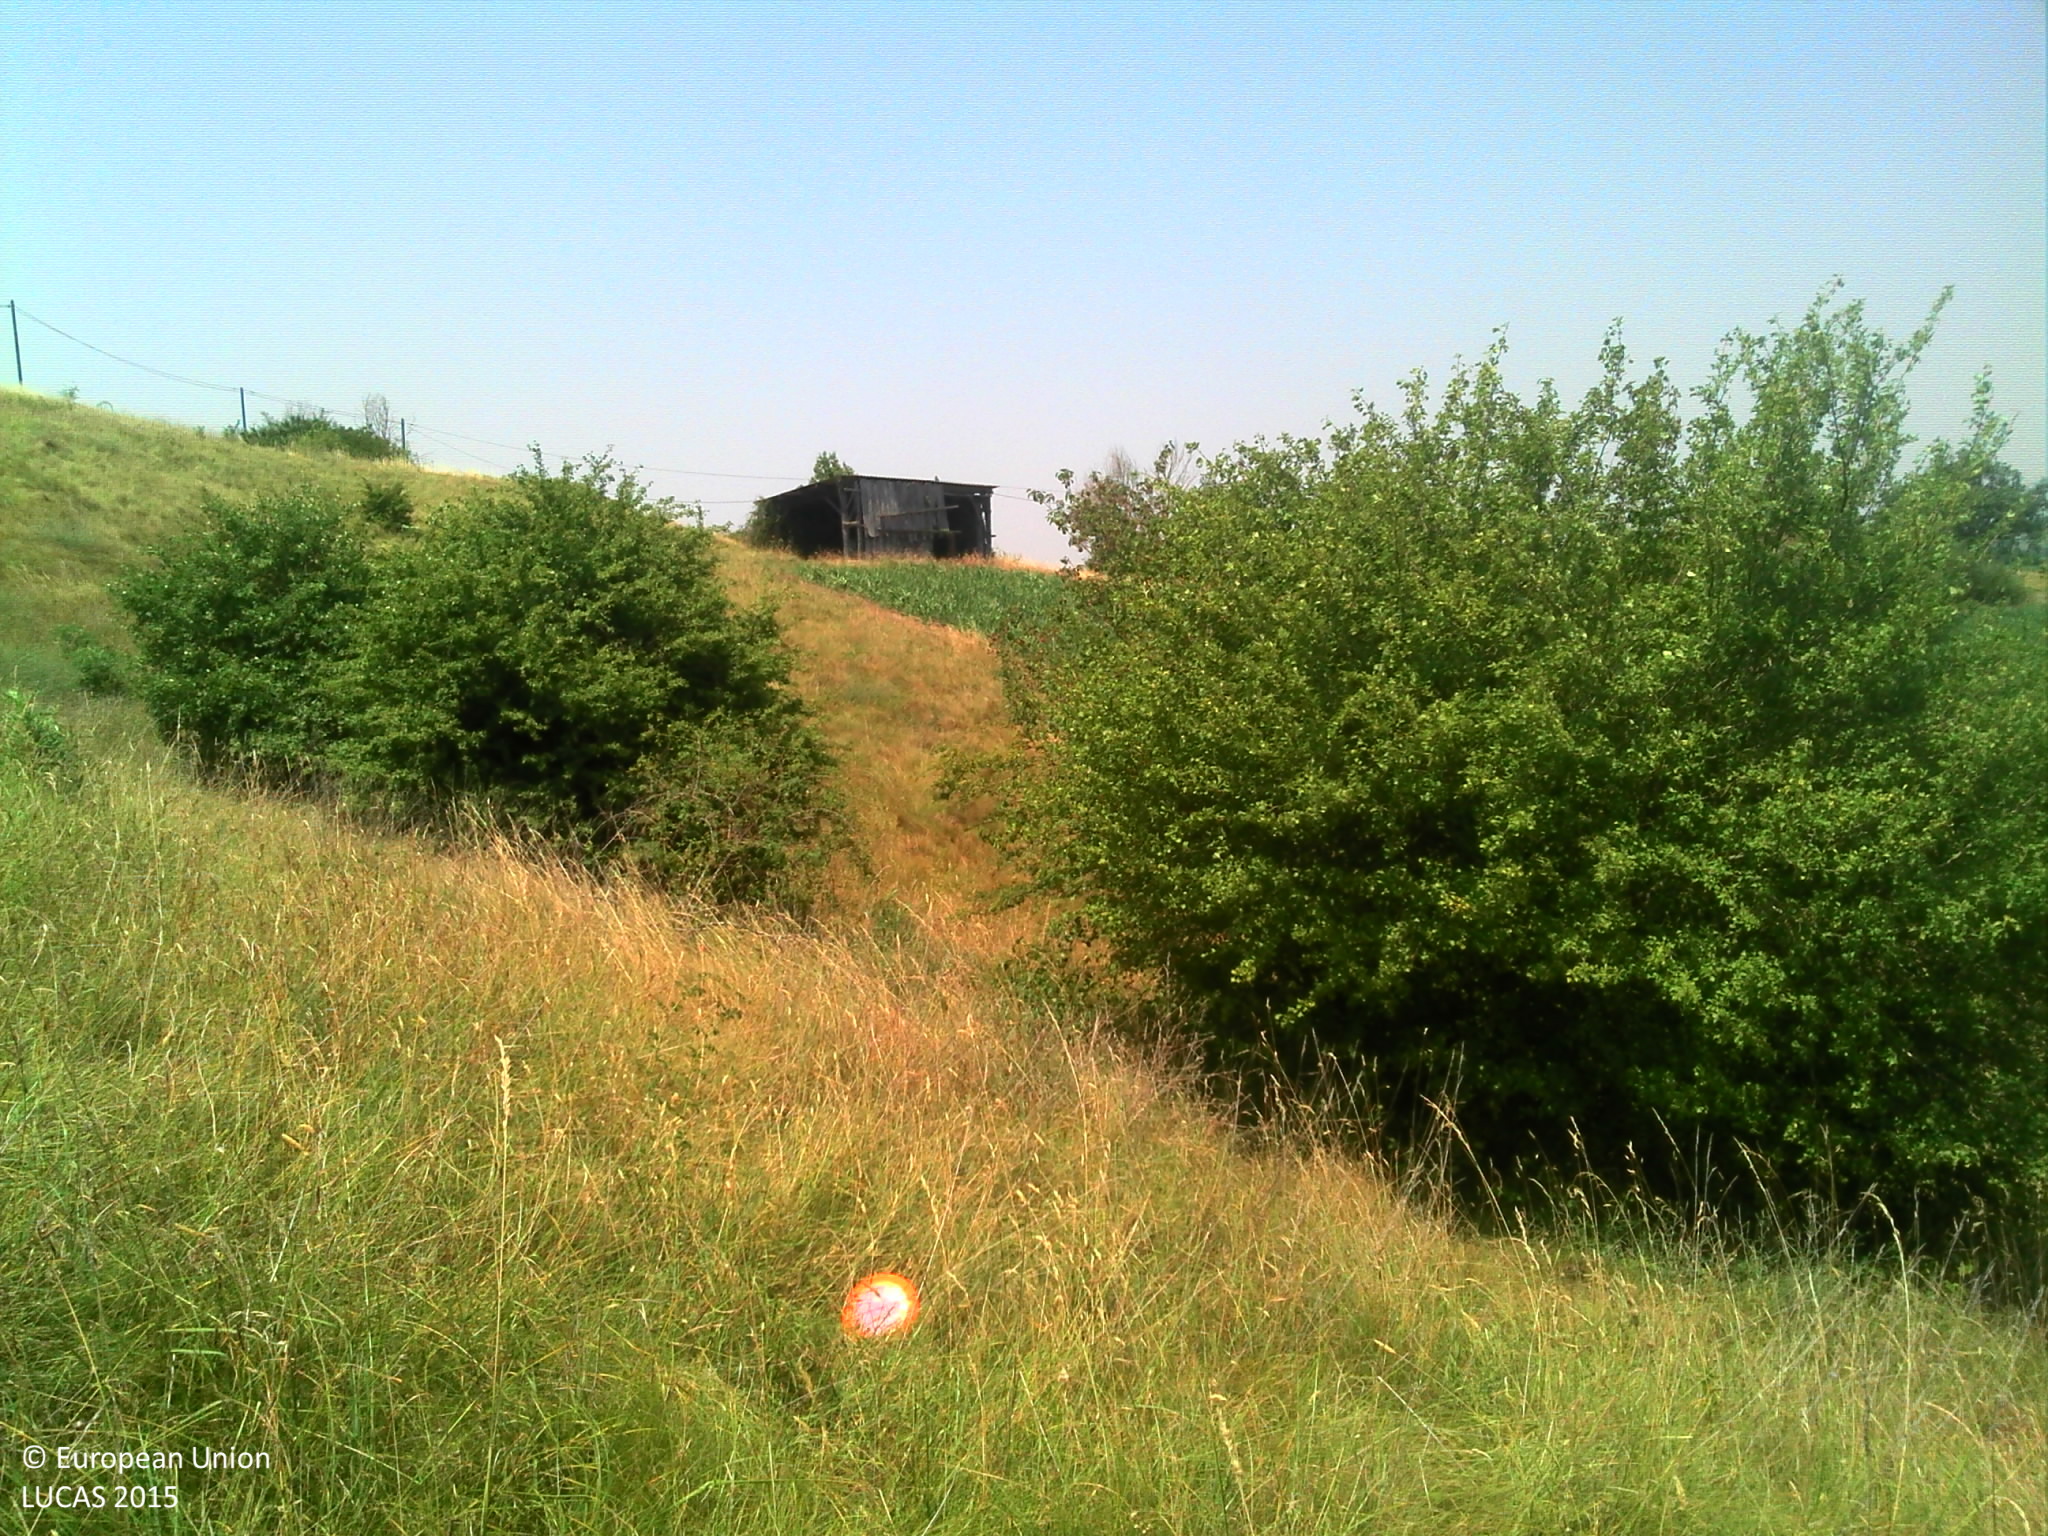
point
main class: Grassland
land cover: Grassland with sparse tree/shrub cover
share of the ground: > 75 %
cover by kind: herbaceous plants 95 %, broadleaved forest trees 5 %
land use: Agriculture (excluding fallow land and kitchen gardens)
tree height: < 5 m
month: July
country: FR
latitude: 43.3270
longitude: 1.0366
